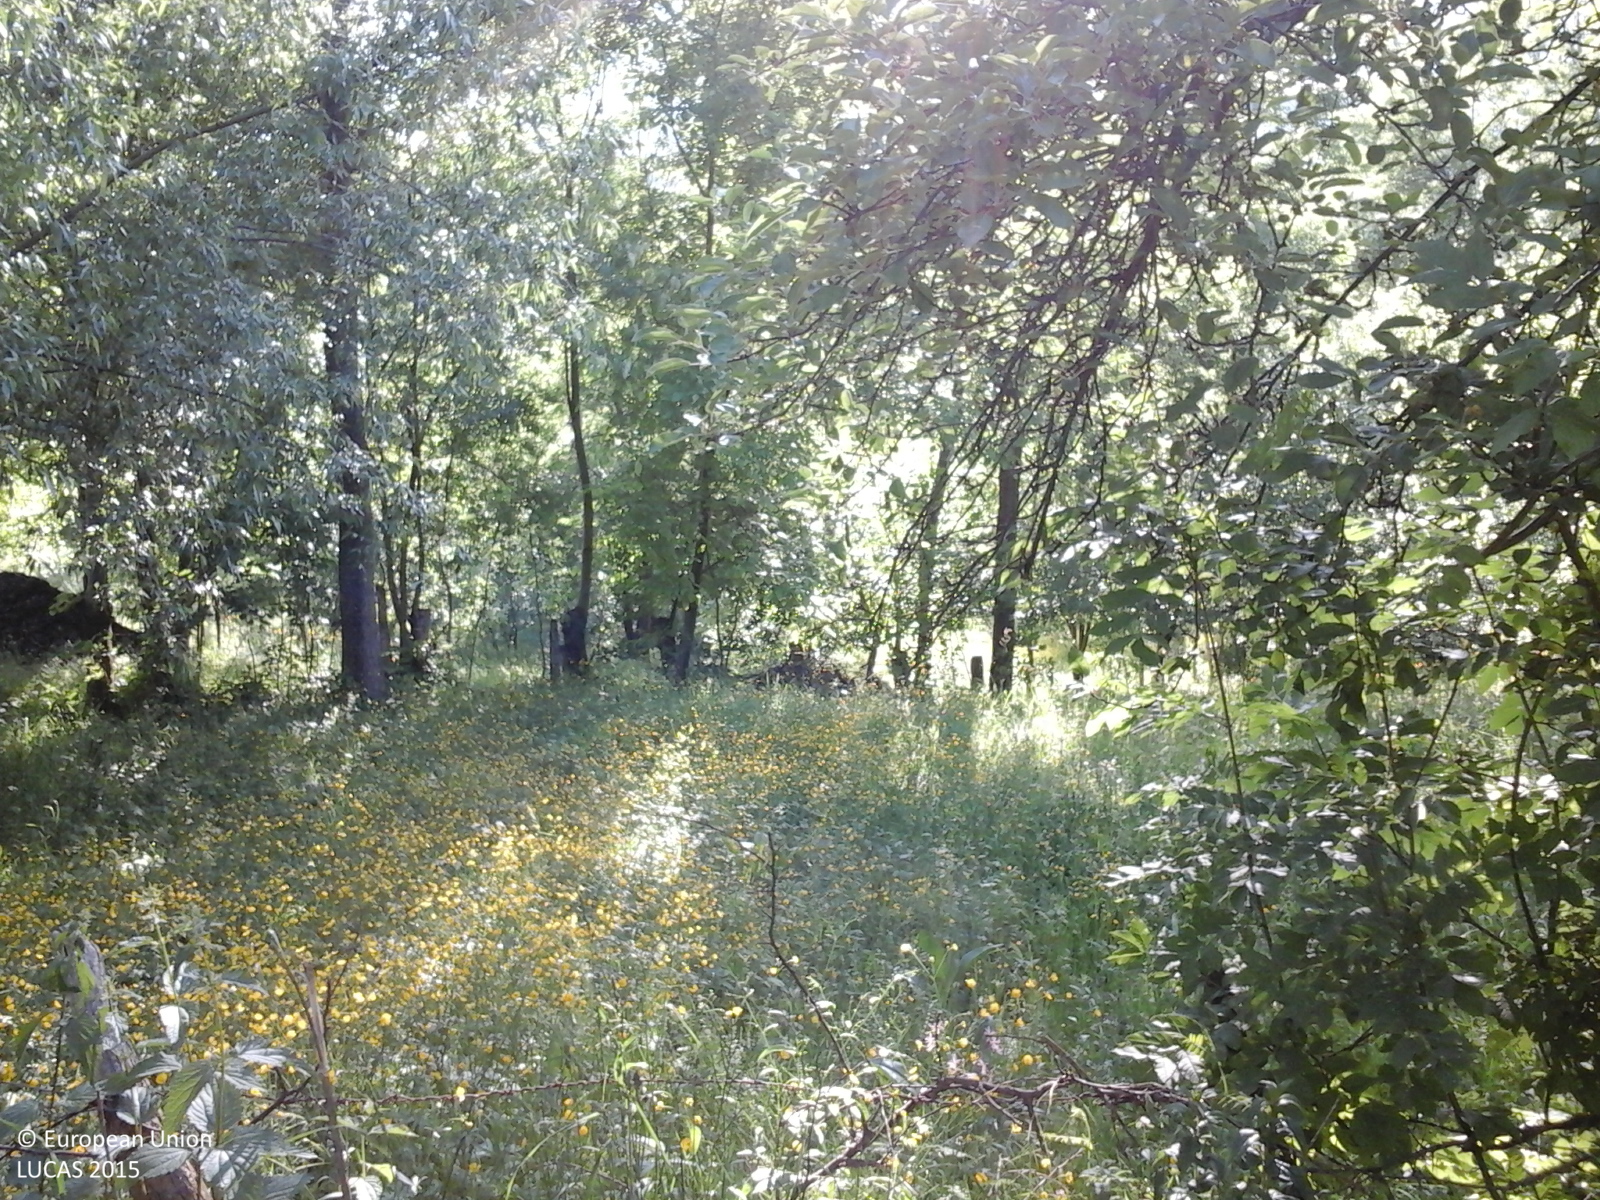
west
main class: Cropland
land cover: Apple fruit
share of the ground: 50 - 75 %
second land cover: Grassland without tree/shrub cover
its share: > 75 %
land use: Agriculture (excluding fallow land and kitchen gardens)
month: May
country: RO
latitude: 45.2213
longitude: 25.8079
